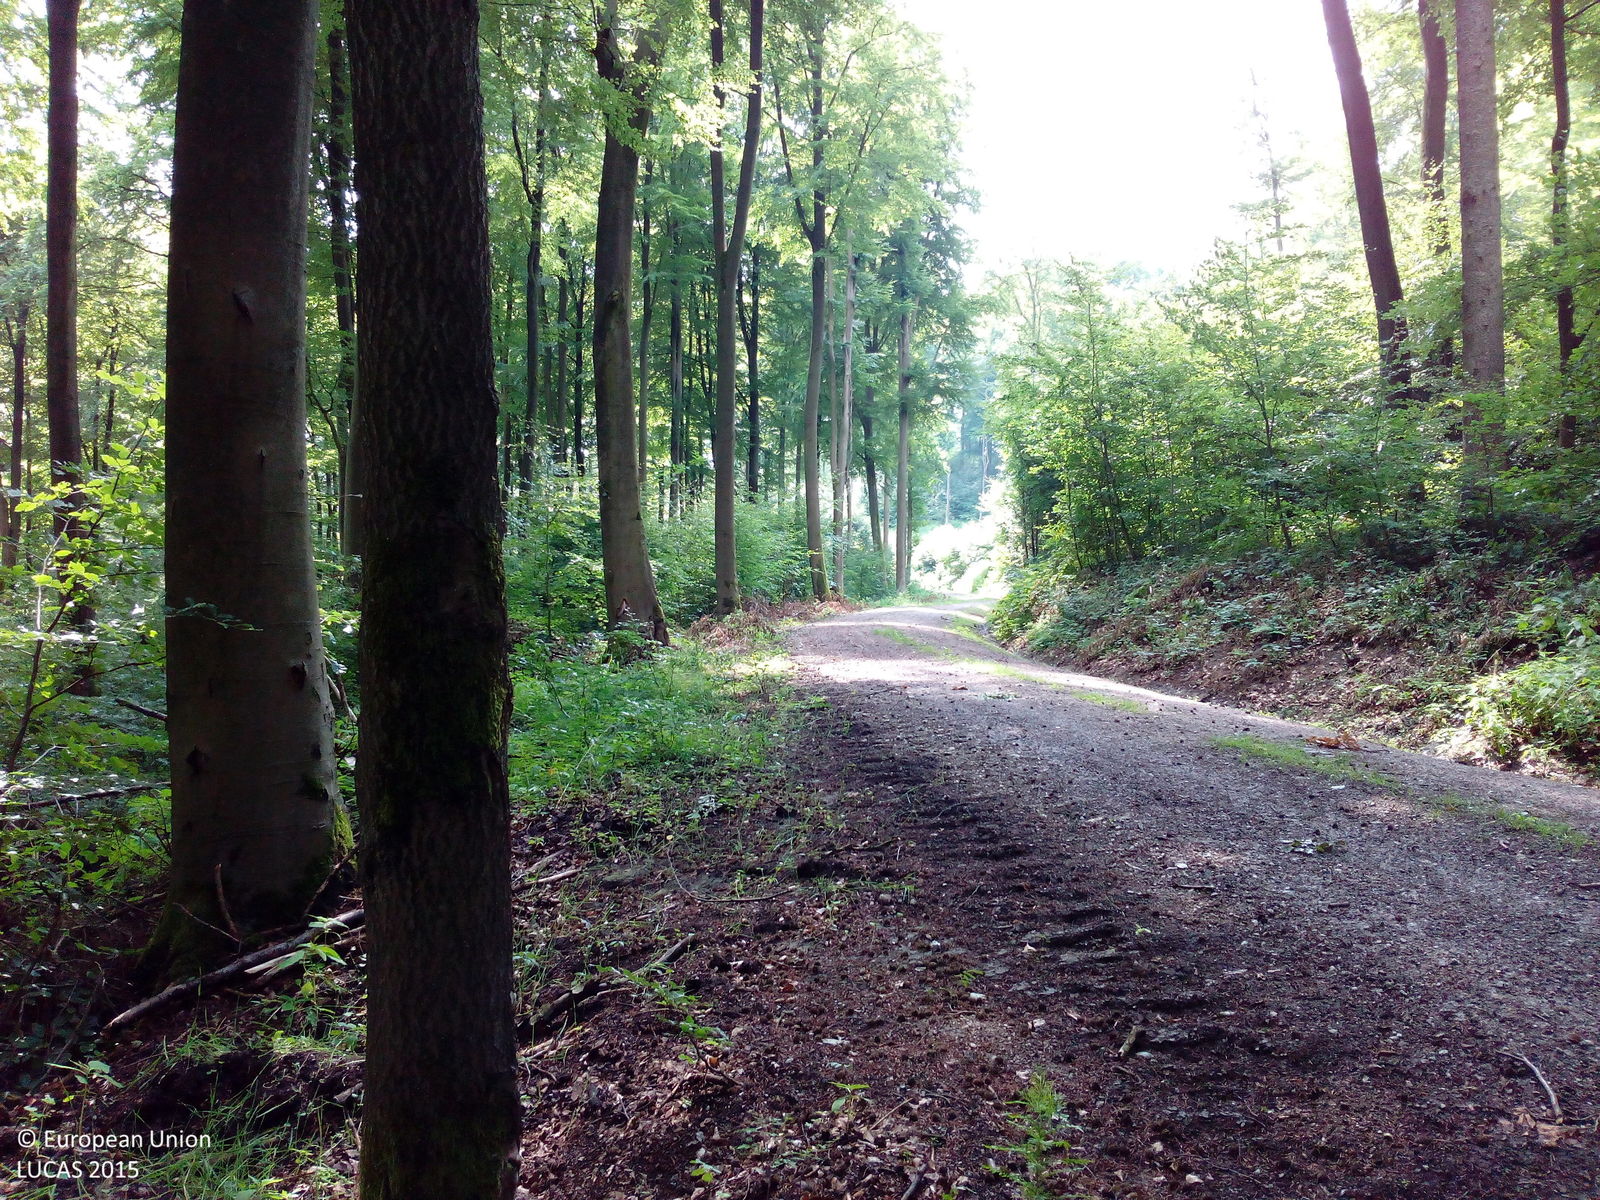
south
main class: Woodland
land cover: Spruce dominated mixed woodland
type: hemiboreal forest and nemoral coniferous forest and mixed broadleaved-coniferous forest
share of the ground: > 75 %
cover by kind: coniferous forest trees 75 %, broadleaved forest trees 25 %
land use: Forestry
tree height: > 5 m
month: July
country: DE
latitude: 51.9281
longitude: 9.9273
